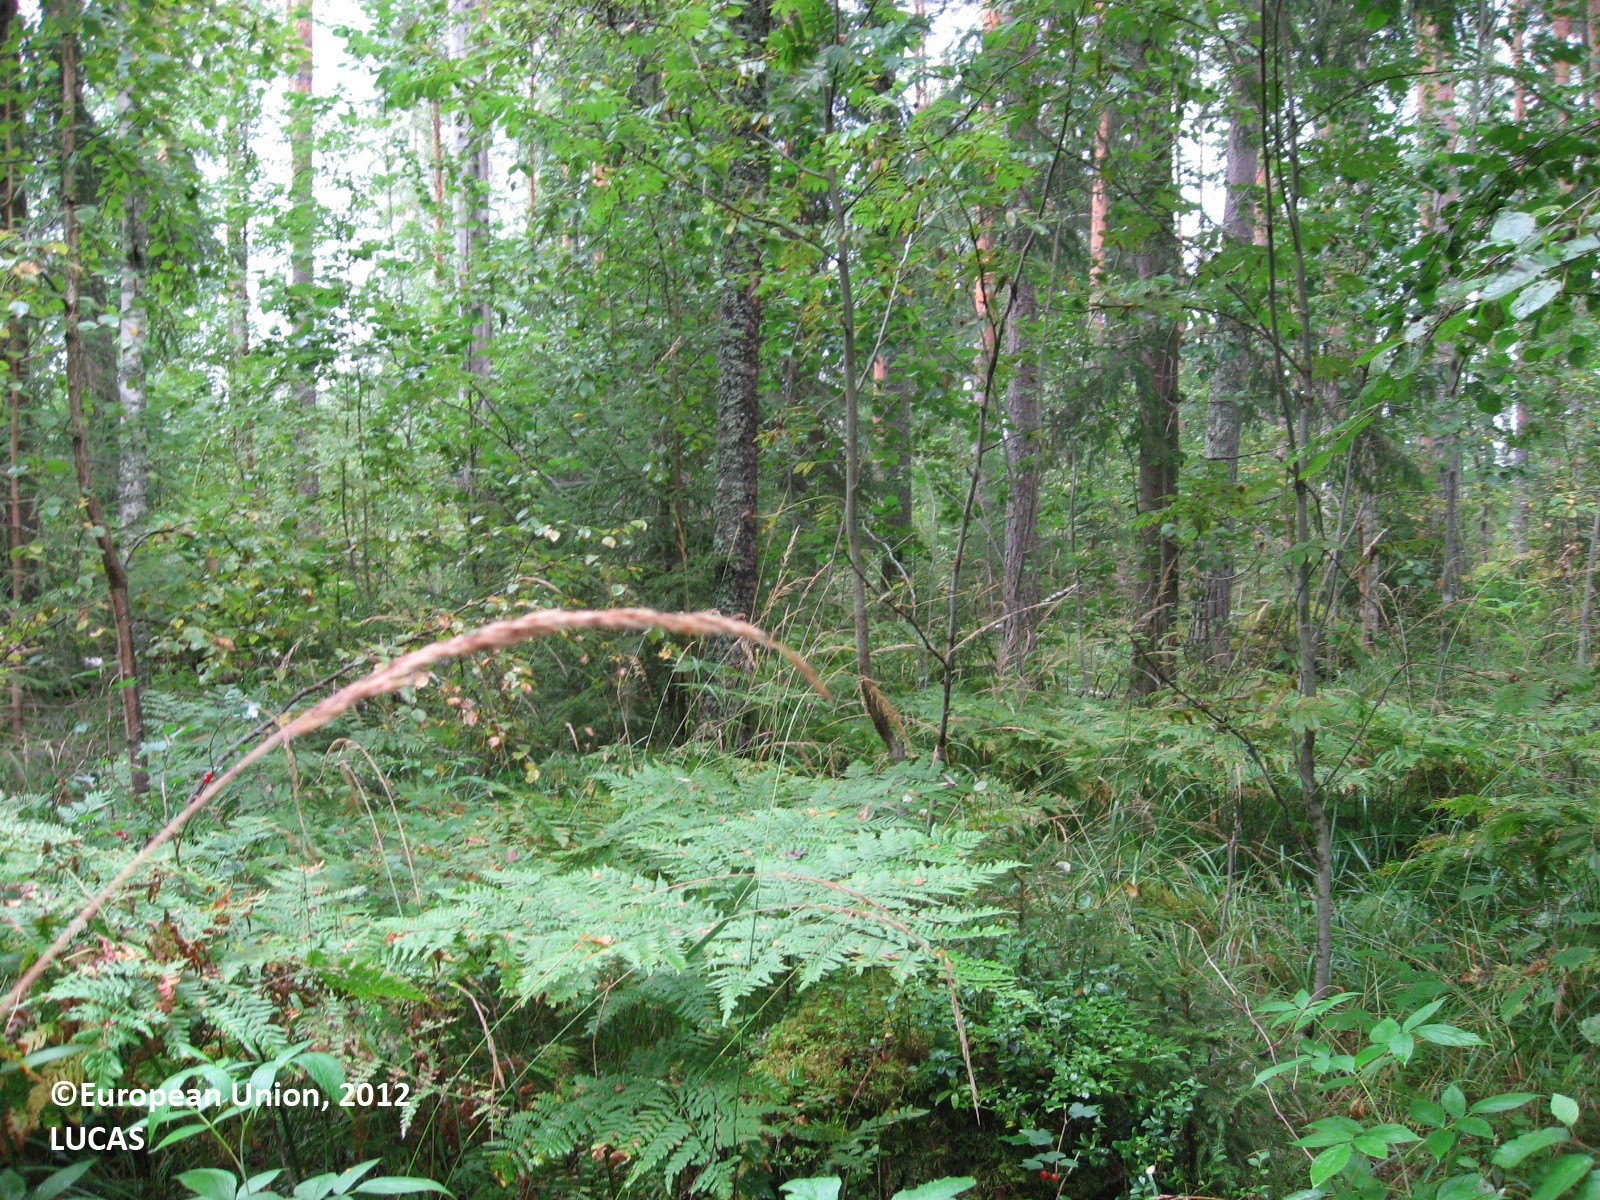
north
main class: Woodland
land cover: Spruce dominated mixed woodland
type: boreal forest
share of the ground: 50 - 75 %
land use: Forestry
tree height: > 5 m
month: August
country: FI
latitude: 61.3686
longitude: 24.7151
